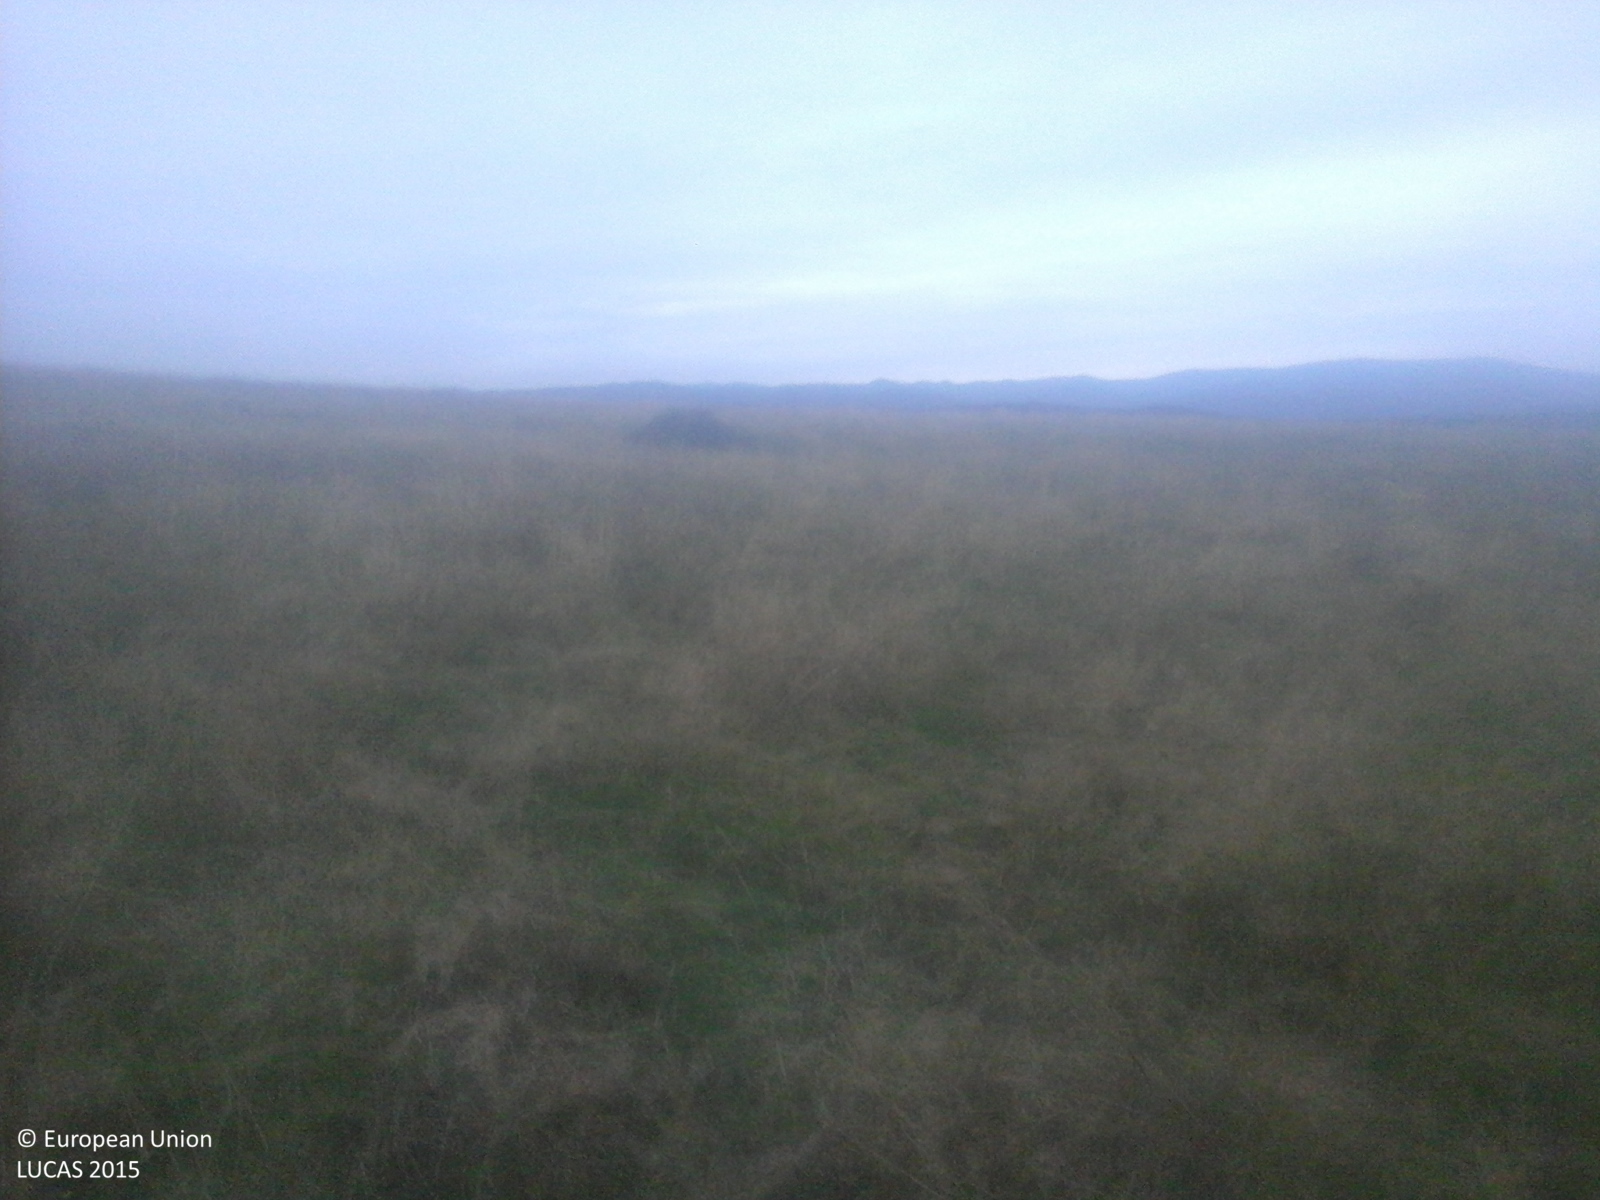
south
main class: Grassland
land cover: Grassland with sparse tree/shrub cover
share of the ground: > 75 %
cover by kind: herbaceous plants 85 %, shrubs 10 %, broadleaved forest trees 5 %
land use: Agriculture (excluding fallow land and kitchen gardens)
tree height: < 5 m
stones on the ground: < 10 %
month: September
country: RO
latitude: 45.8611
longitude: 23.3142
